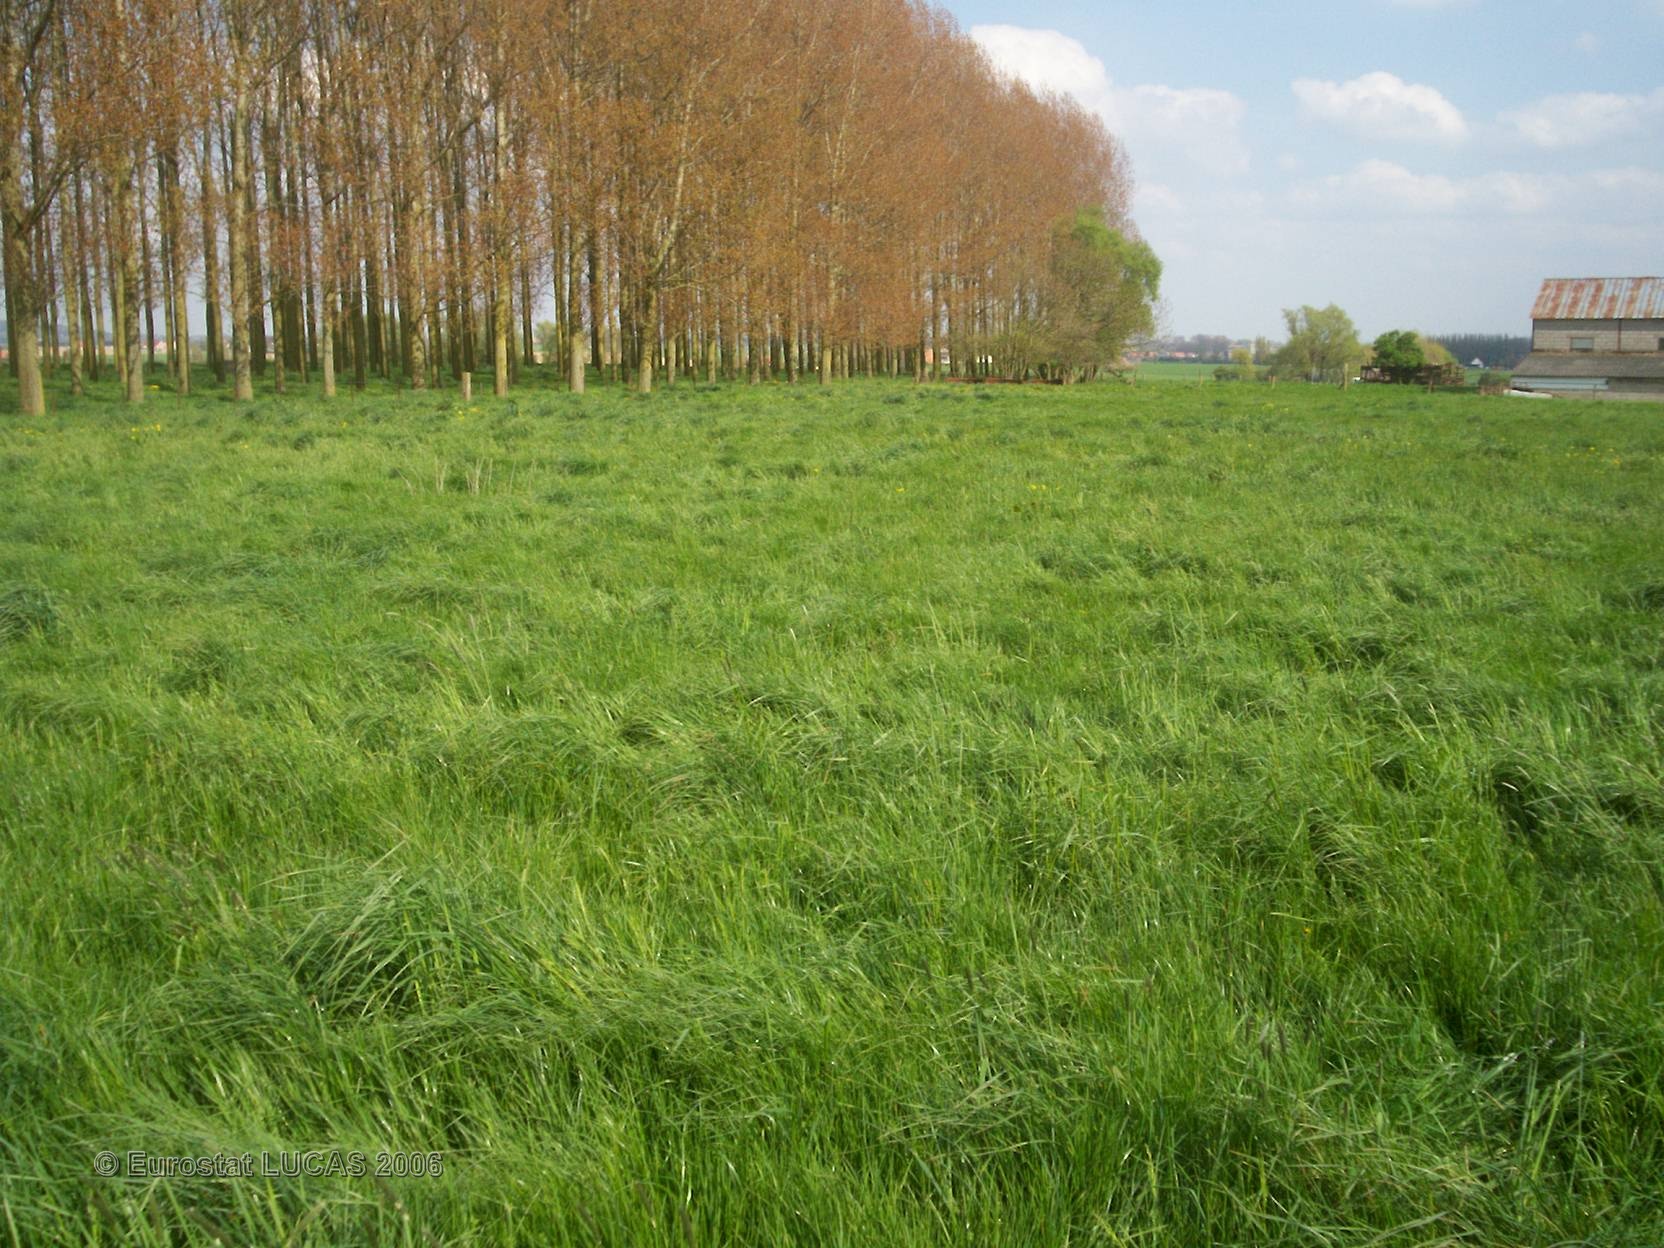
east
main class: Grassland
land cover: Grassland without tree/shrub cover
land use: Agriculture (excluding fallow land and kitchen gardens)
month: May
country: FR
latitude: 50.7724
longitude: 2.5714
